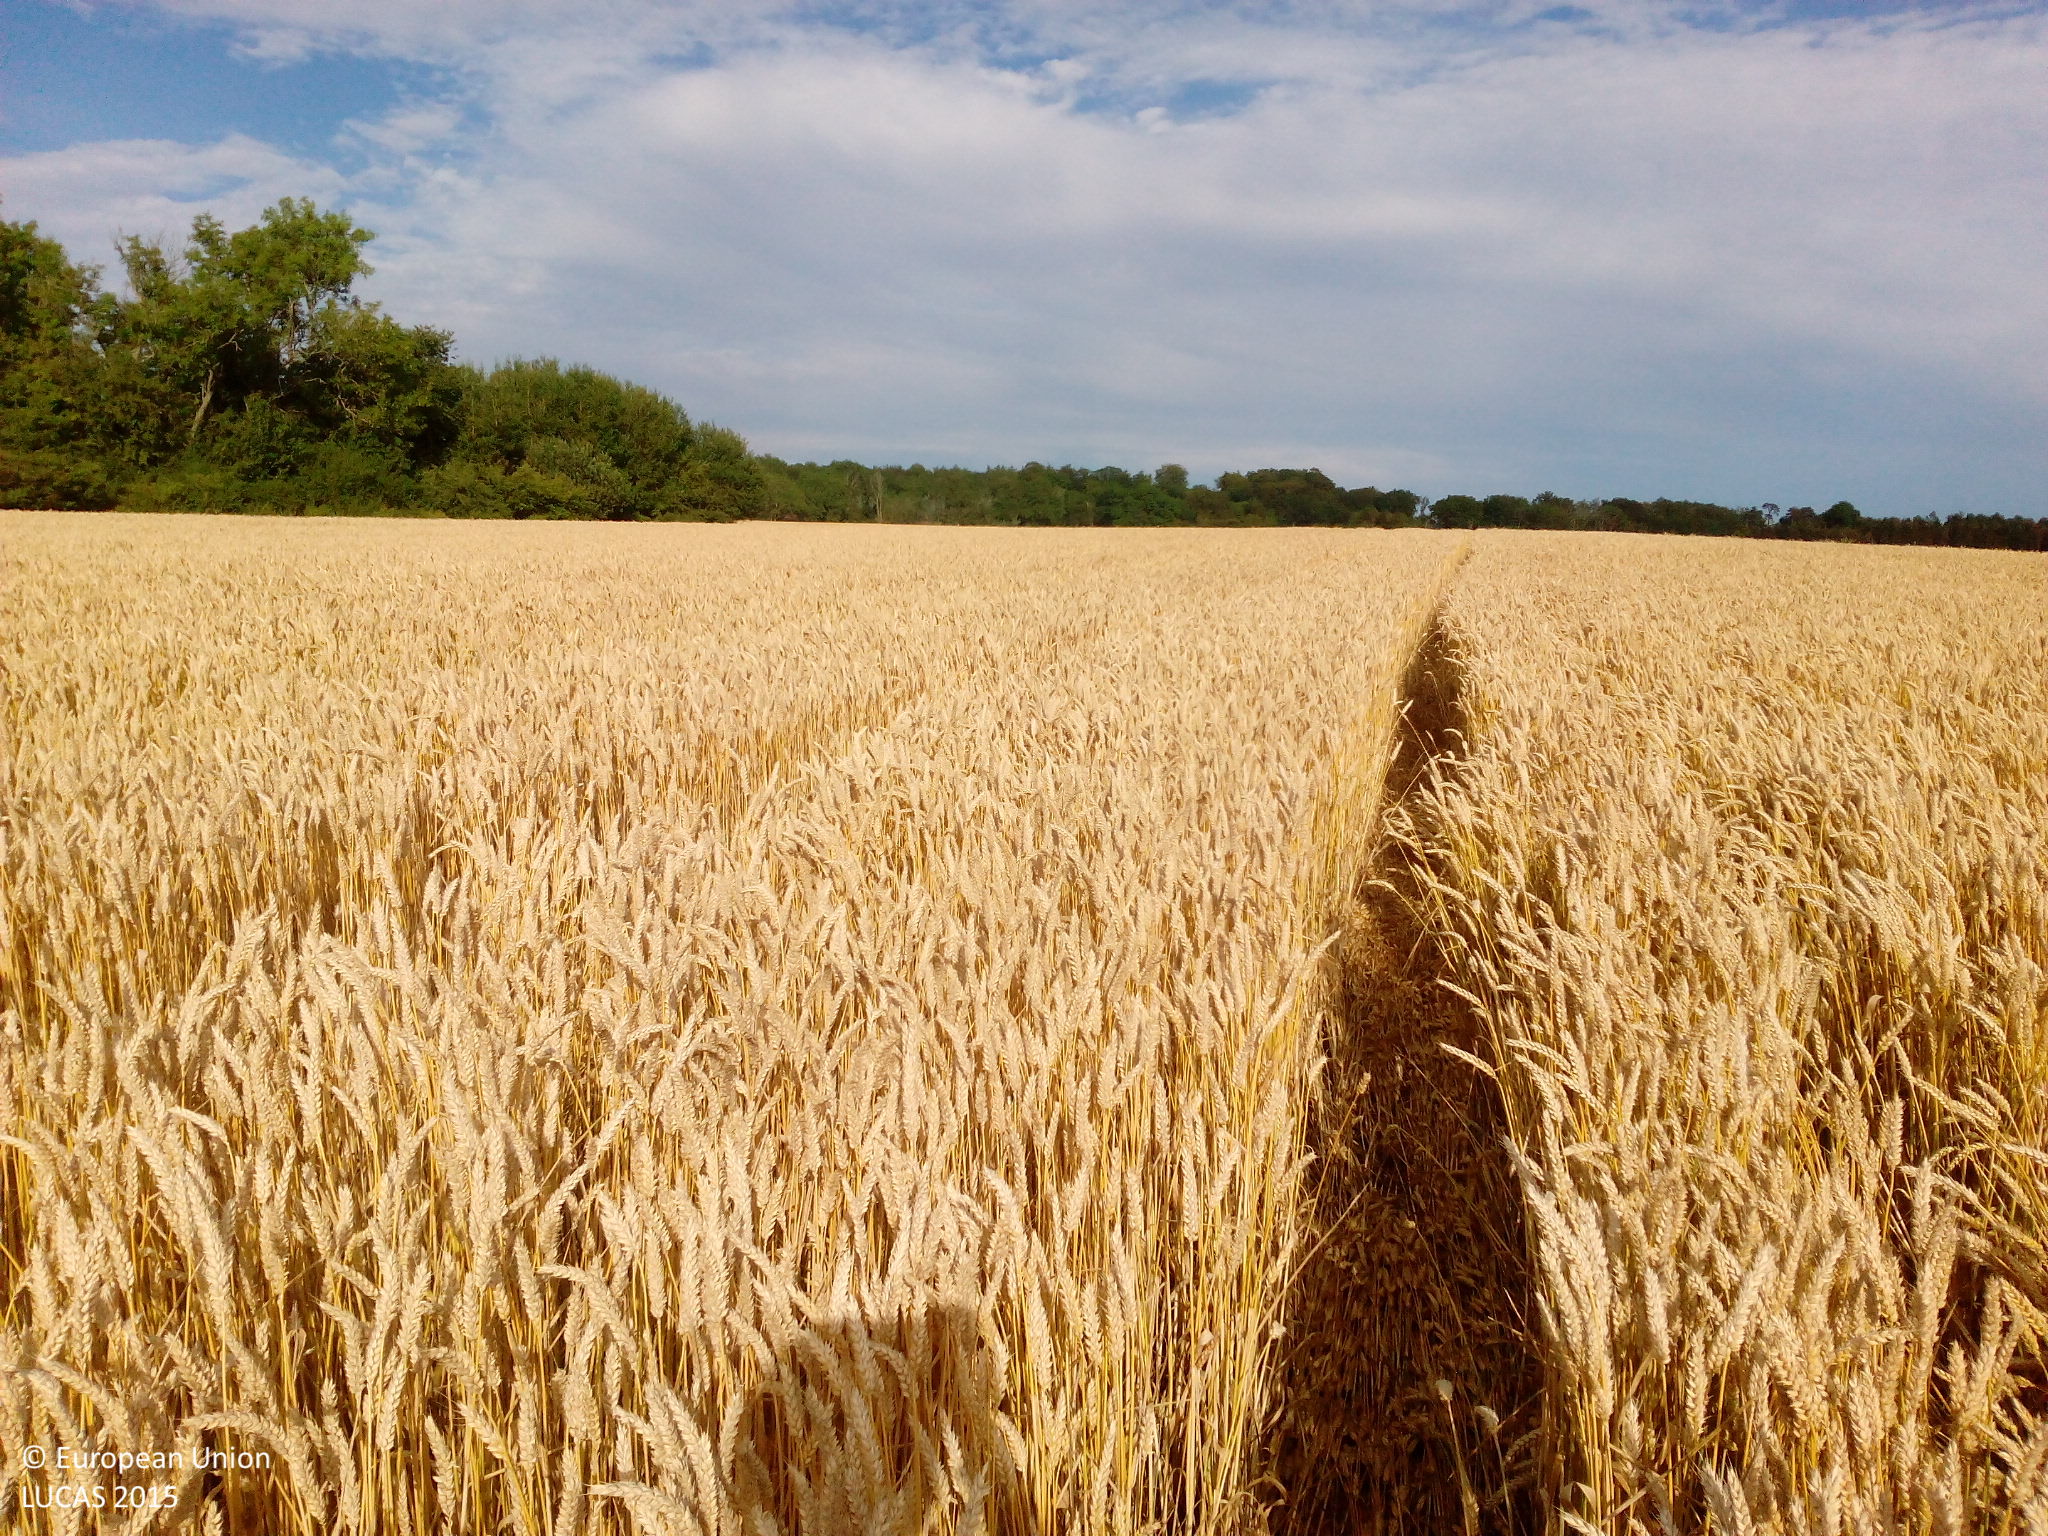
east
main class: Cropland
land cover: Common wheat
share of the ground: > 75 %
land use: Agriculture (excluding fallow land and kitchen gardens)
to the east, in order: Common wheat
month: August
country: DK
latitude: 55.6016
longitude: 11.6650
